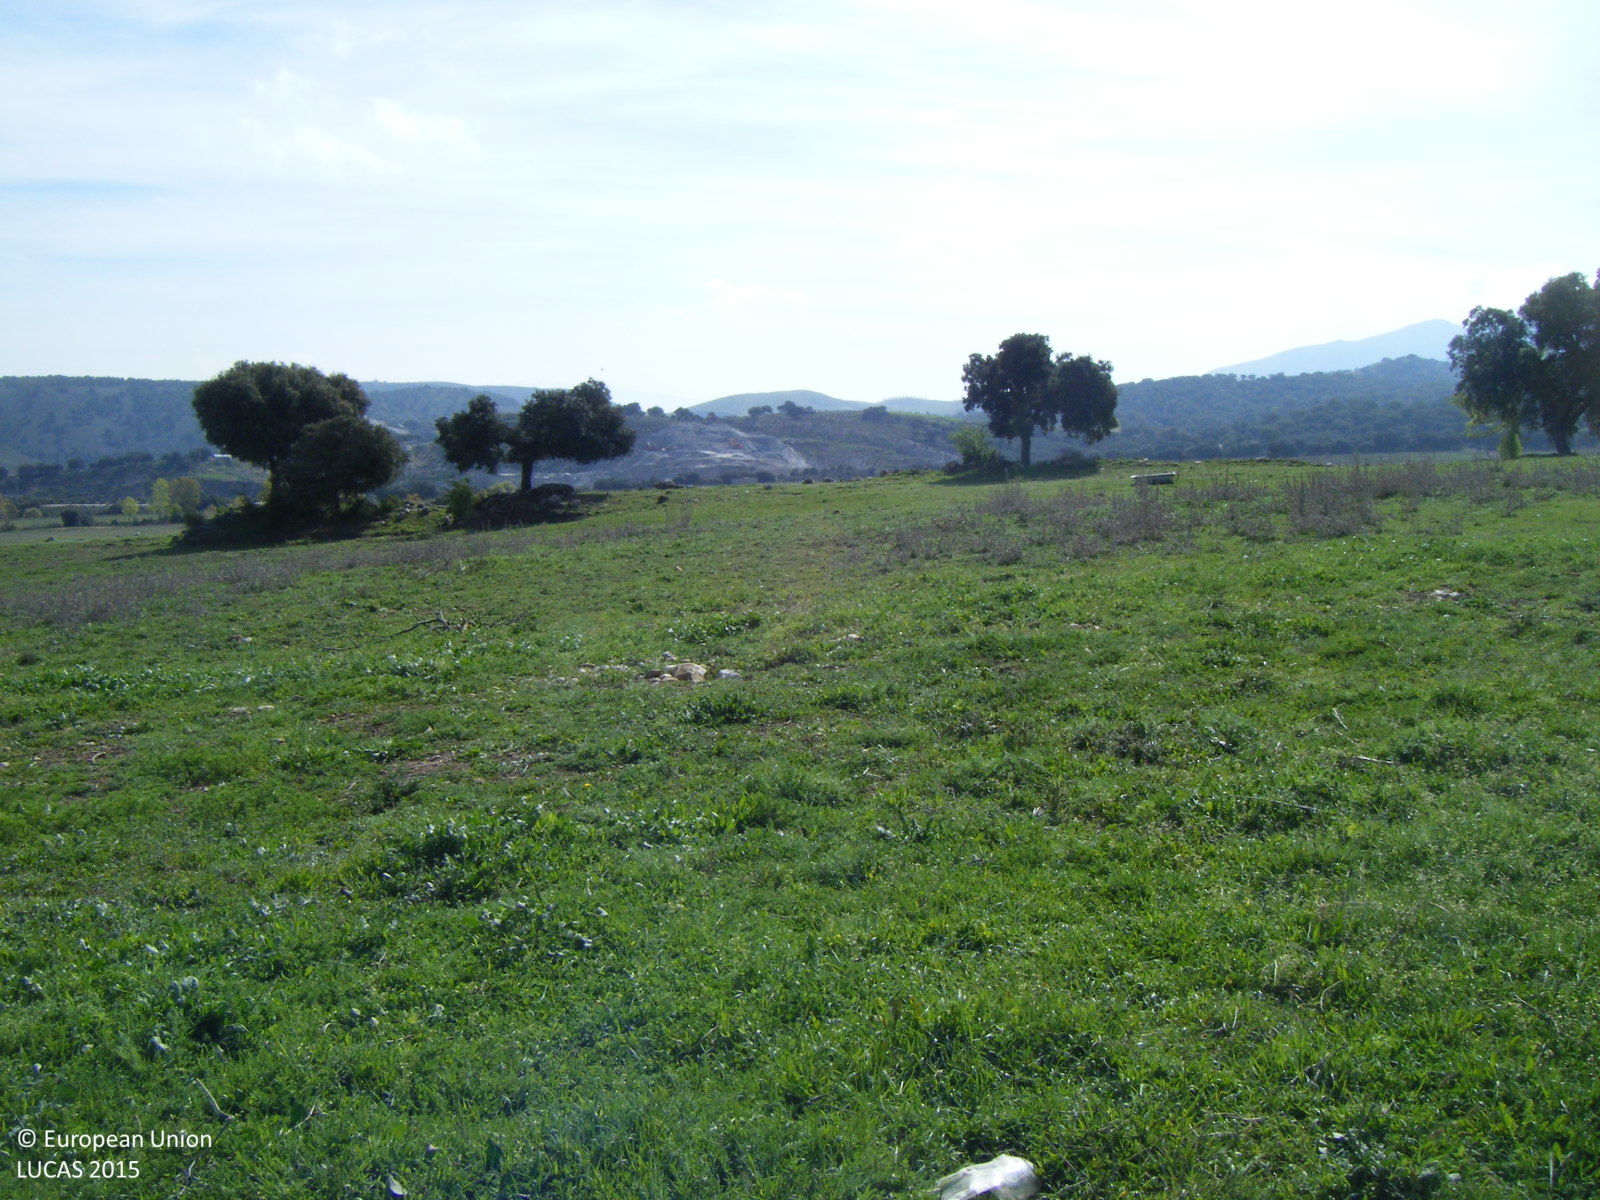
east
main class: Grassland
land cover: Spontaneously vegetated surfaces
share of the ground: > 75 %
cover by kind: herbaceous plants 100 %
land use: Agriculture (excluding fallow land and kitchen gardens)
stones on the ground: < 10 %
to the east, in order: Spontaneously vegetated surfaces; Tracks; Grassland without tree/shrub cover; Lines of trees
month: April
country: ES
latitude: 36.9398
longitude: -4.0360
